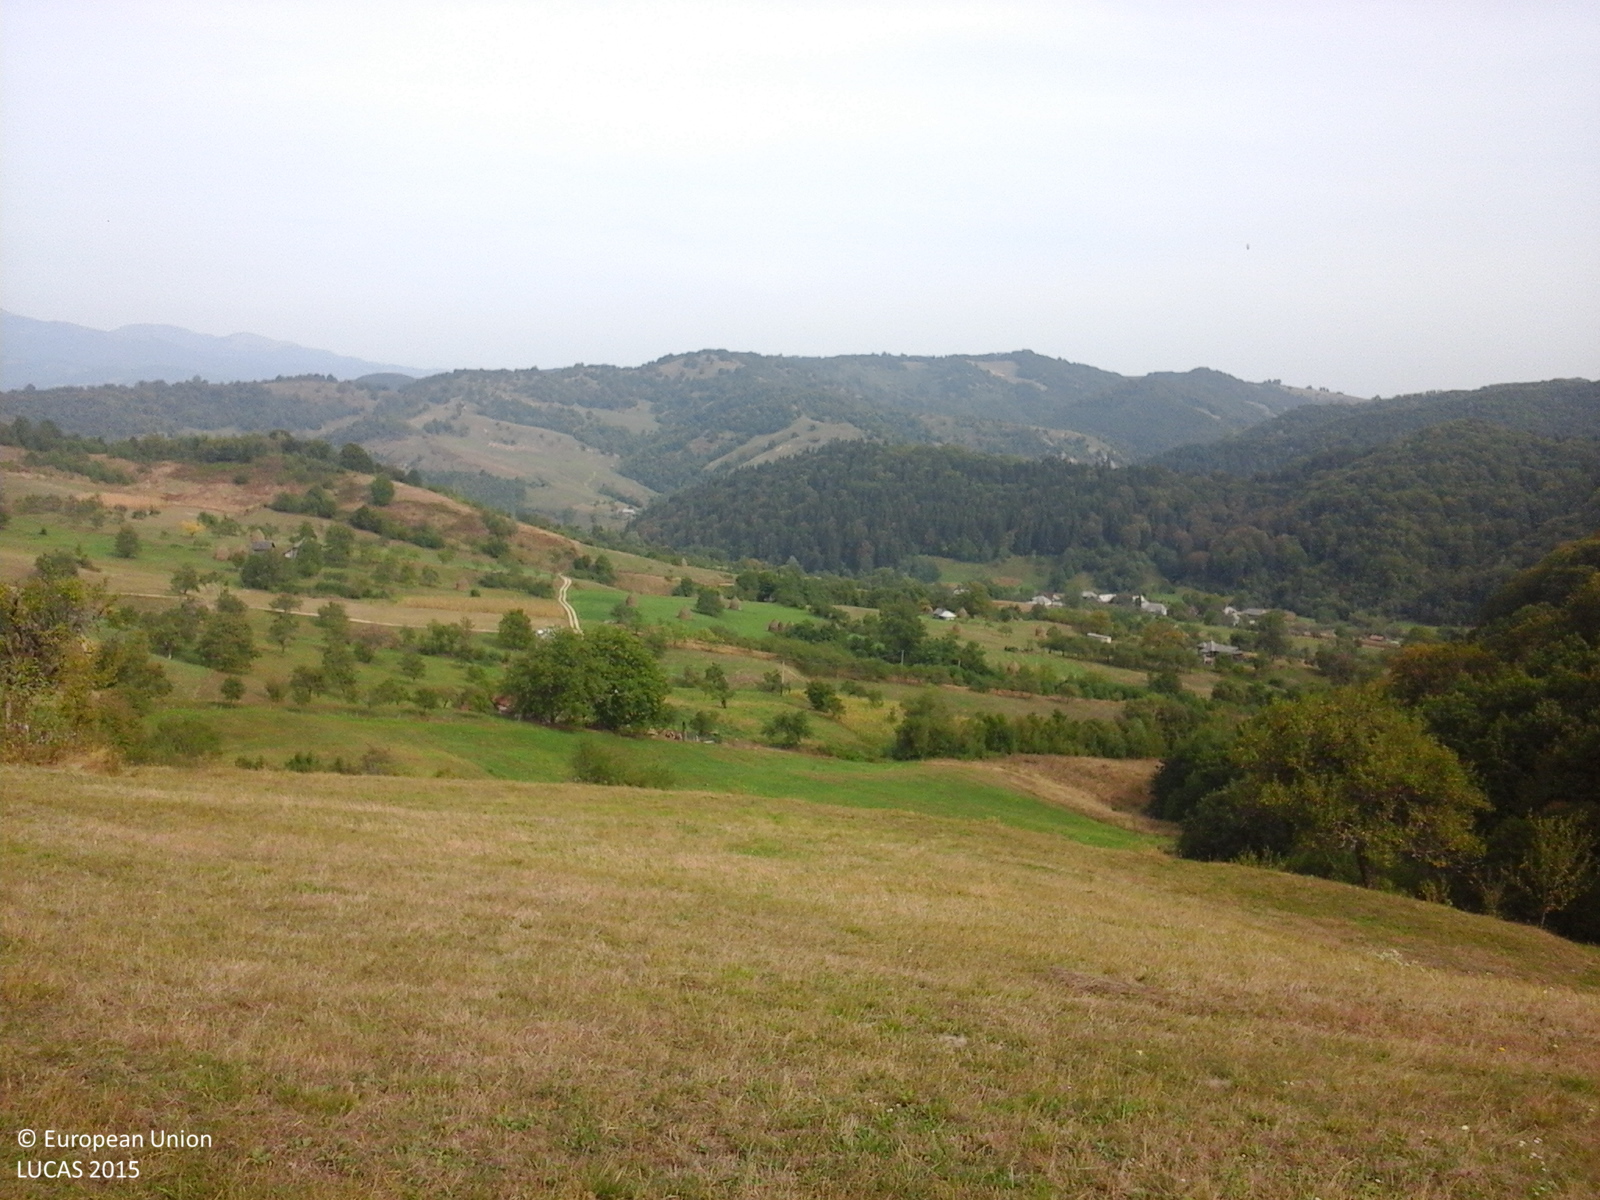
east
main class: Grassland
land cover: Grassland without tree/shrub cover
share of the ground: > 75 %
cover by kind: herbaceous plants 100 %
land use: Agriculture (excluding fallow land and kitchen gardens)
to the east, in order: Grassland without tree/shrub cover; Tracks; Grassland without tree/shrub cover; Other fruit trees and berries; Tracks; Grassland without tree/shrub cover
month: September
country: RO
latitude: 47.4143
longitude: 24.0126
